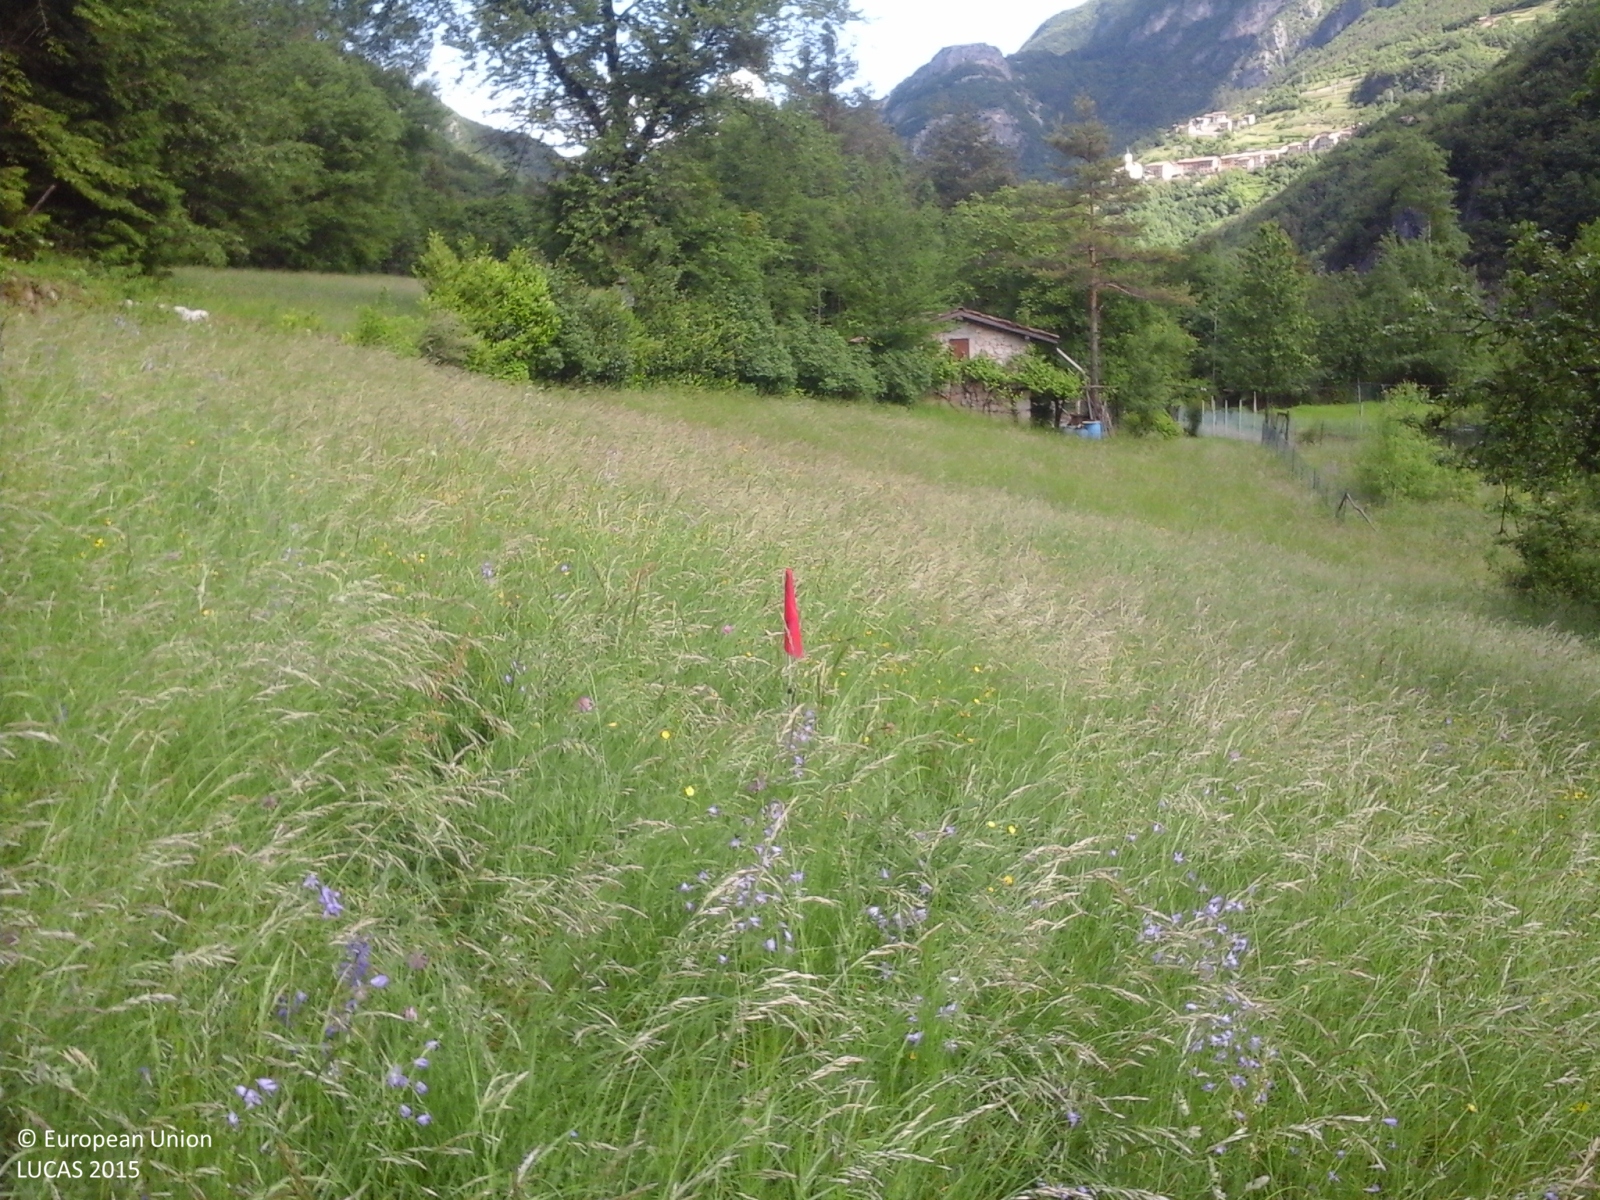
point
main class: Grassland
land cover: Grassland with sparse tree/shrub cover
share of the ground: > 75 %
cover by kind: herbaceous plants 95 %, broadleaved forest trees 5 %
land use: Semi-natural and natural areas not in use
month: May
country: IT
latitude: 45.8051
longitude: 11.0920
